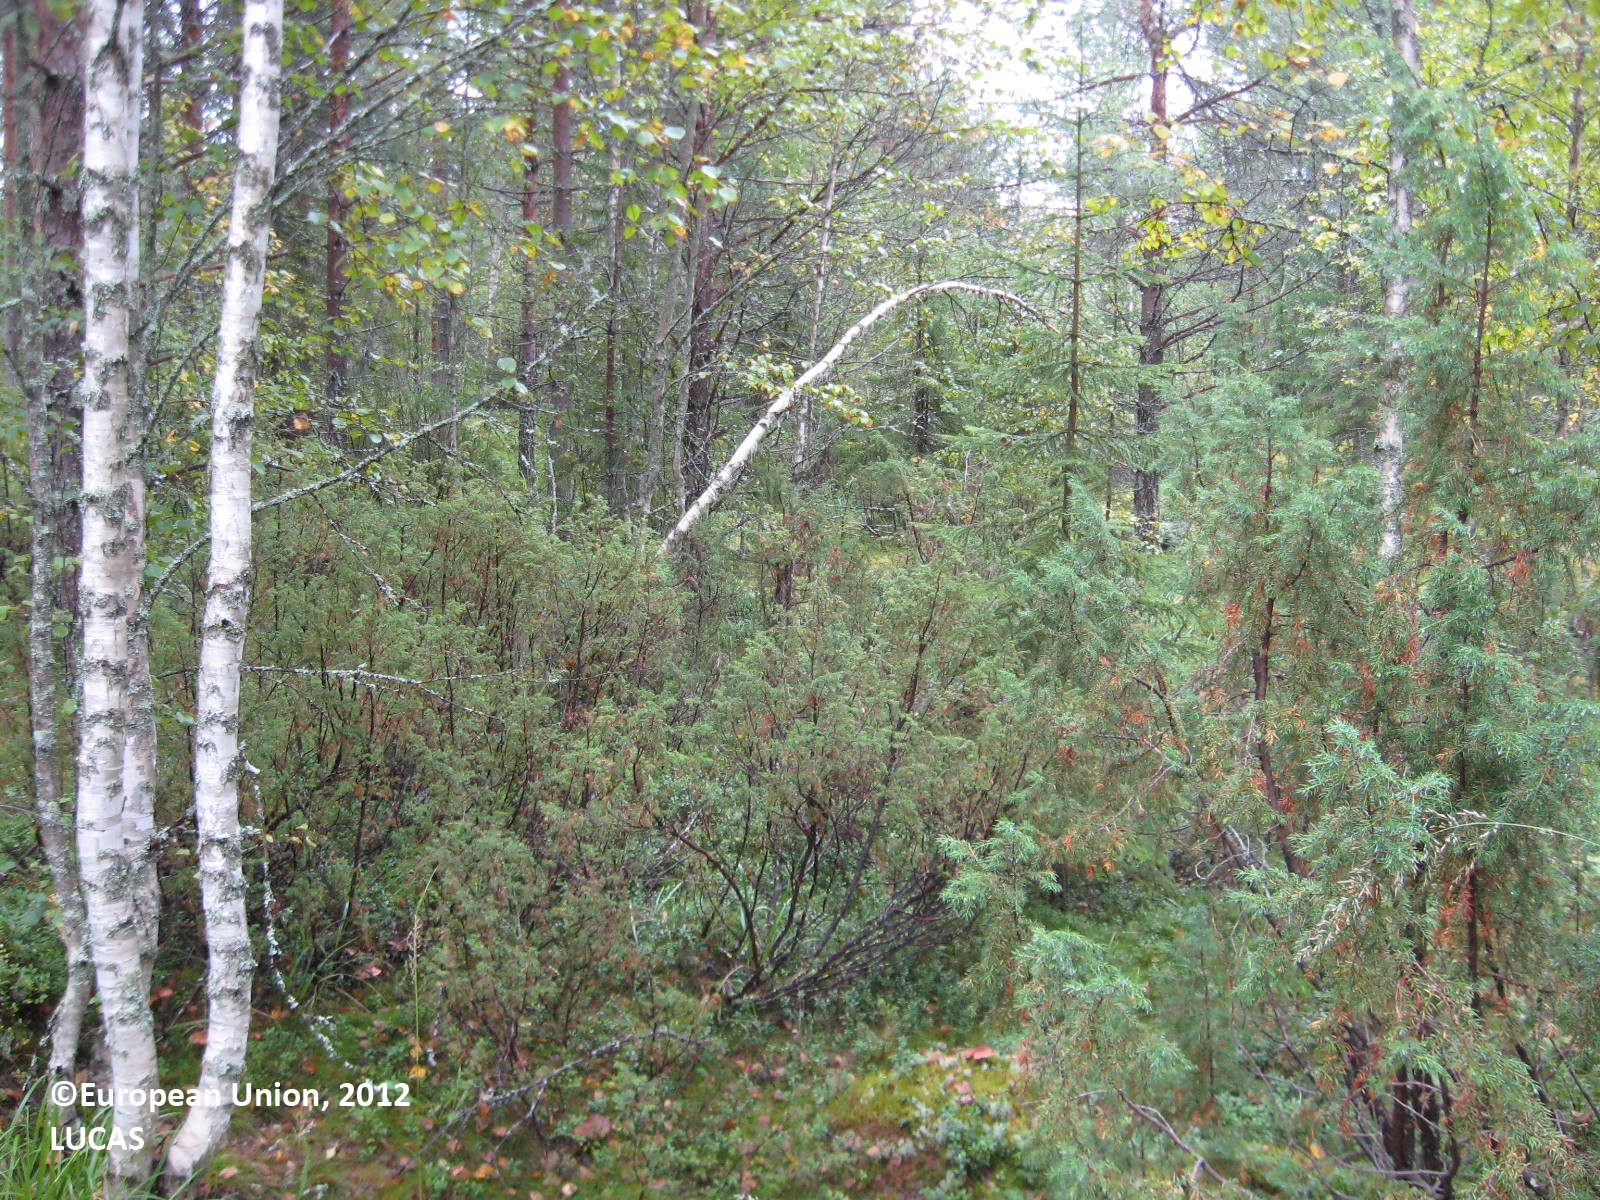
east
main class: Woodland
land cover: Pine dominated coniferous woodland
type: boreal forest
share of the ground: > 75 %
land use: Forestry
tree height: > 5 m
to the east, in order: Pine dominated coniferous woodland; Spruce dominated coniferous woodland; Ditches and canals; Spruce dominated coniferous woodland; Other mixed woodland; Ditches and canals; Spruce dominated coniferous woodland
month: August
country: FI
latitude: 63.5104
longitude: 29.4564
